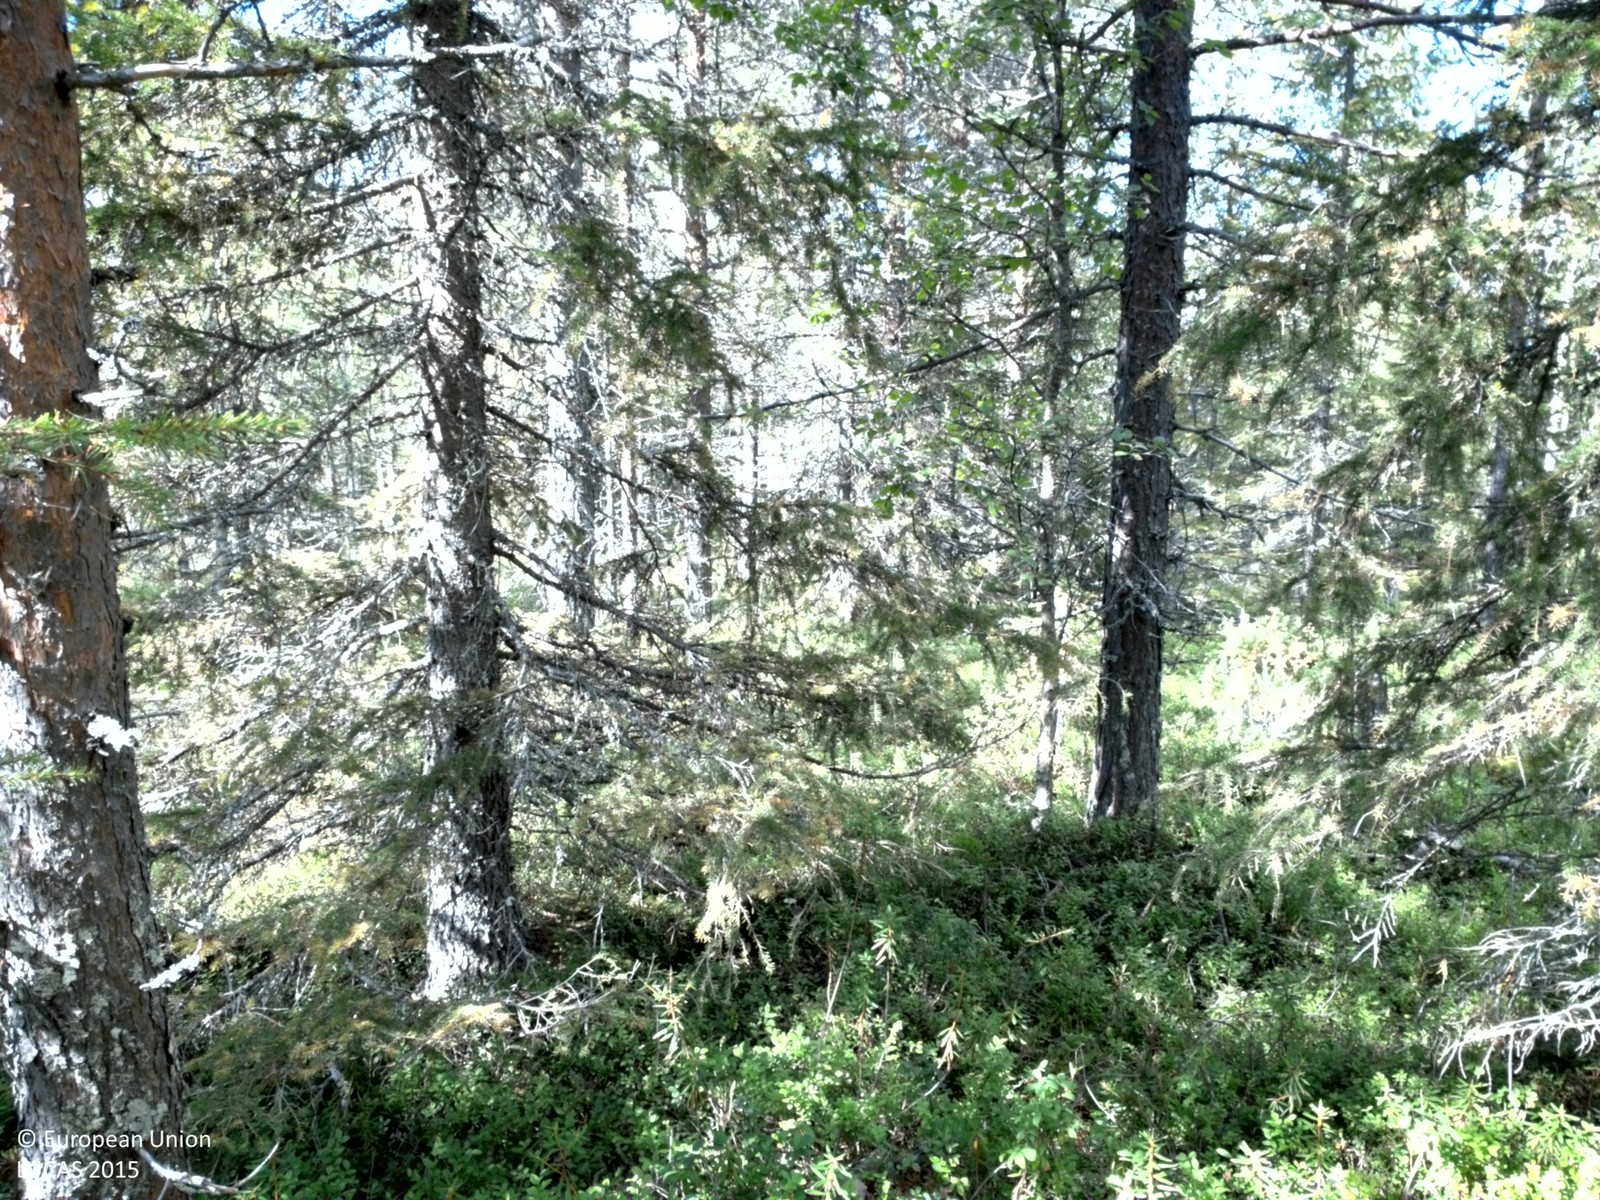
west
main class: Woodland
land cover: Pine dominated coniferous woodland
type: boreal forest
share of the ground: 25 - 50 %
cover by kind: shrubs 65 %, coniferous forest trees 30 %, broadleaved forest trees 5 %
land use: Forestry
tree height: > 5 m
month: August
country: SE
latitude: 66.1716
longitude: 22.3298
